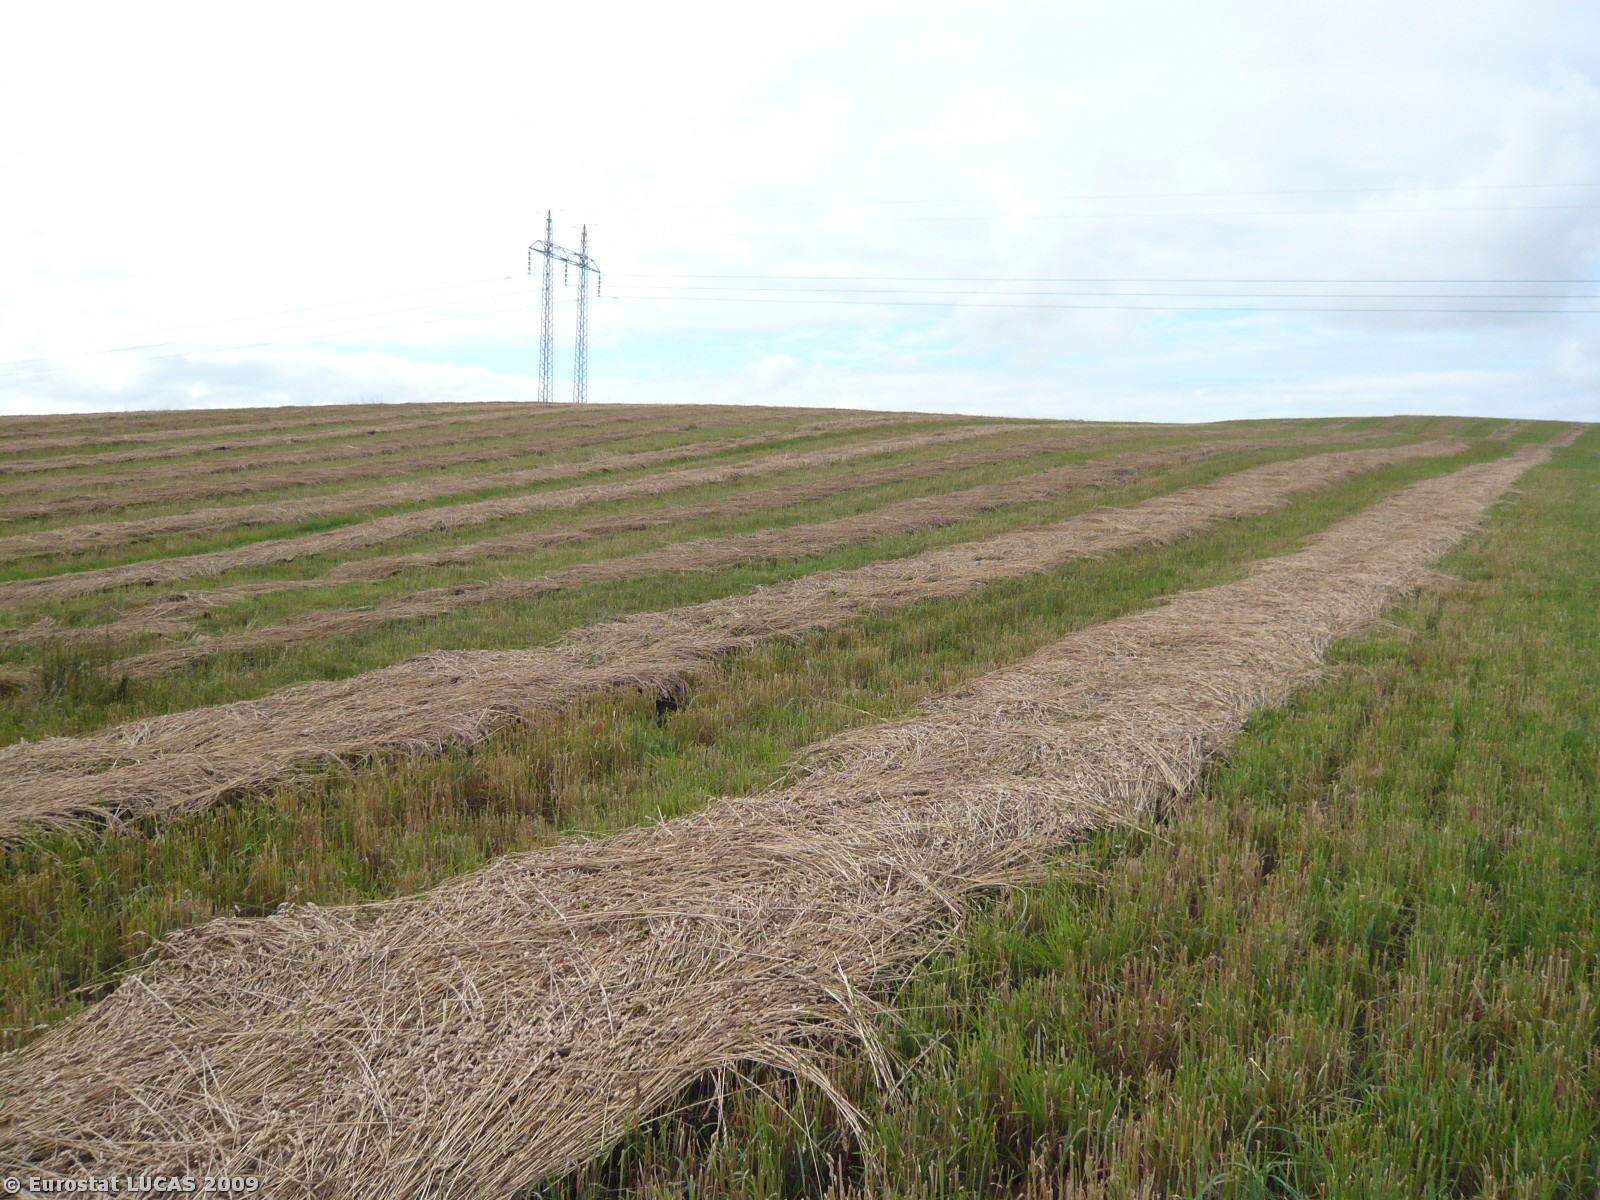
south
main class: Grassland
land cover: Grassland without tree/shrub cover
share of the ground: > 75 %
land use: Agriculture (excluding fallow land and kitchen gardens)
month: July
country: DK
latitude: 55.6240
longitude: 11.2851
